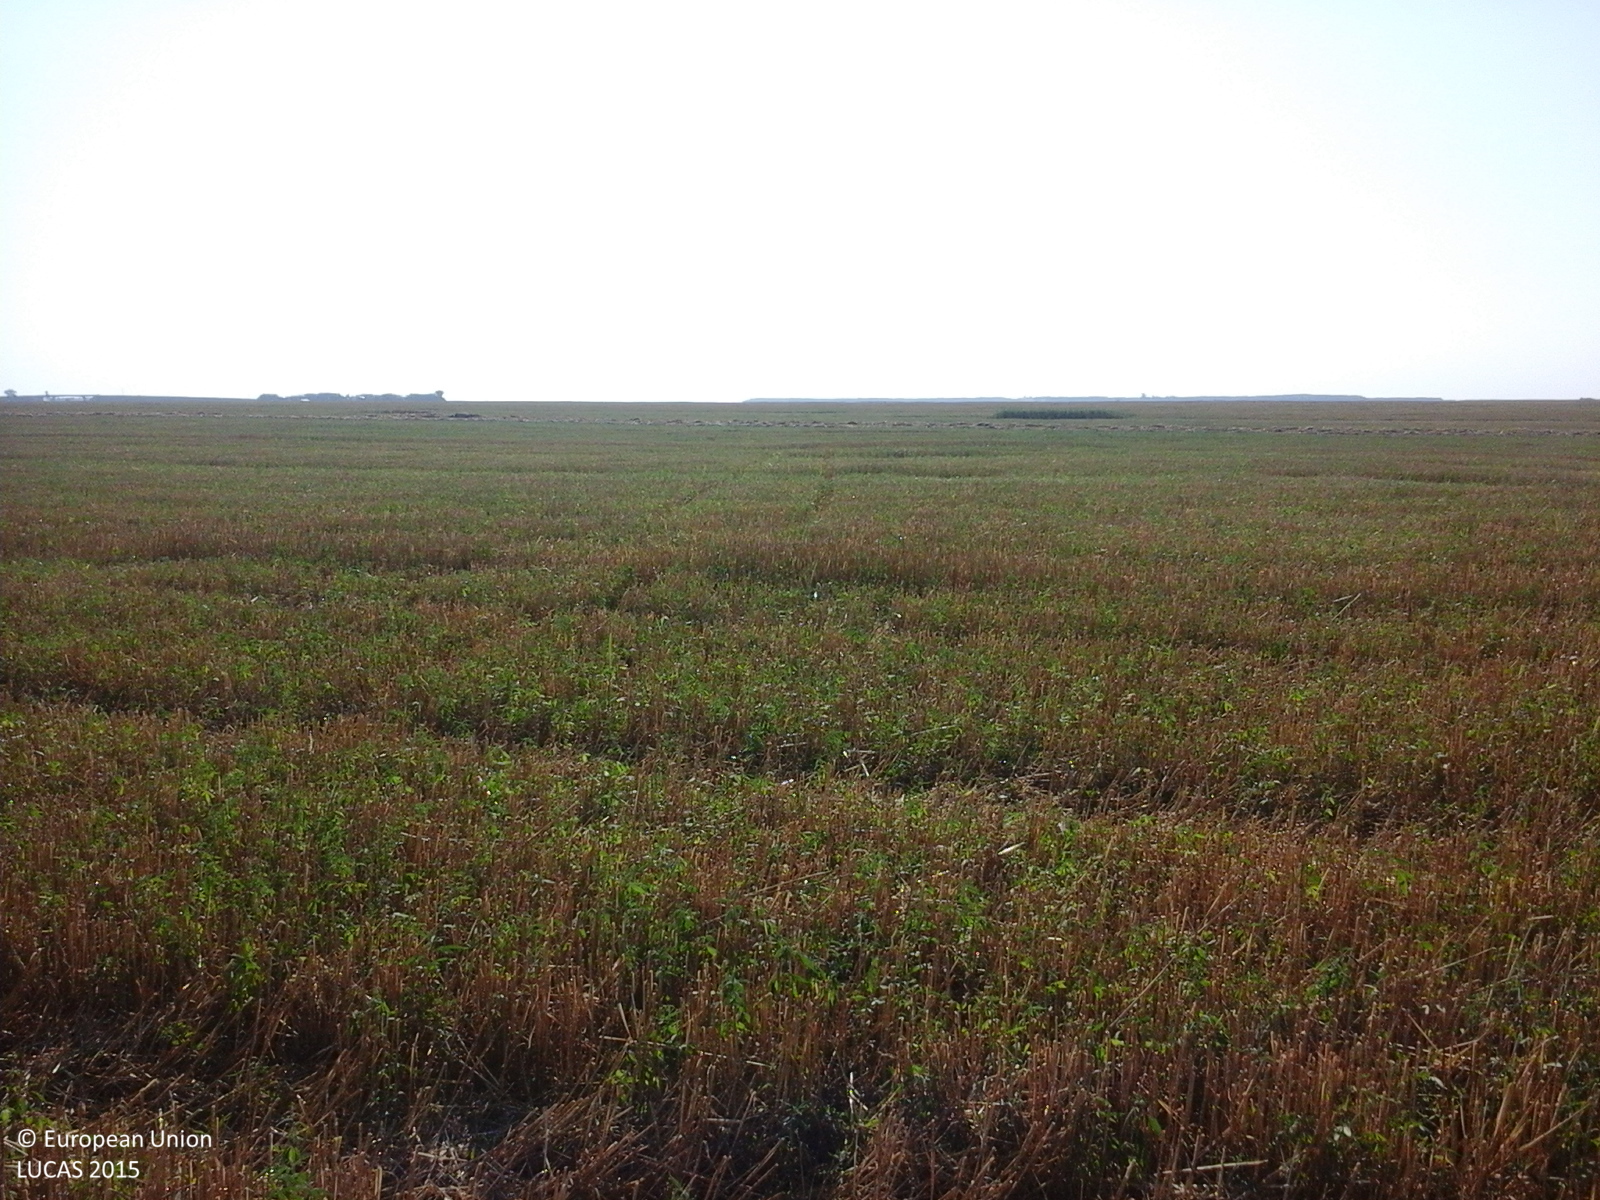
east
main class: Cropland
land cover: Common wheat
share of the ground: > 75 %
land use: Agriculture (excluding fallow land and kitchen gardens)
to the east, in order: Common wheat
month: July
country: RO
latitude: 44.4220
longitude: 27.0221
